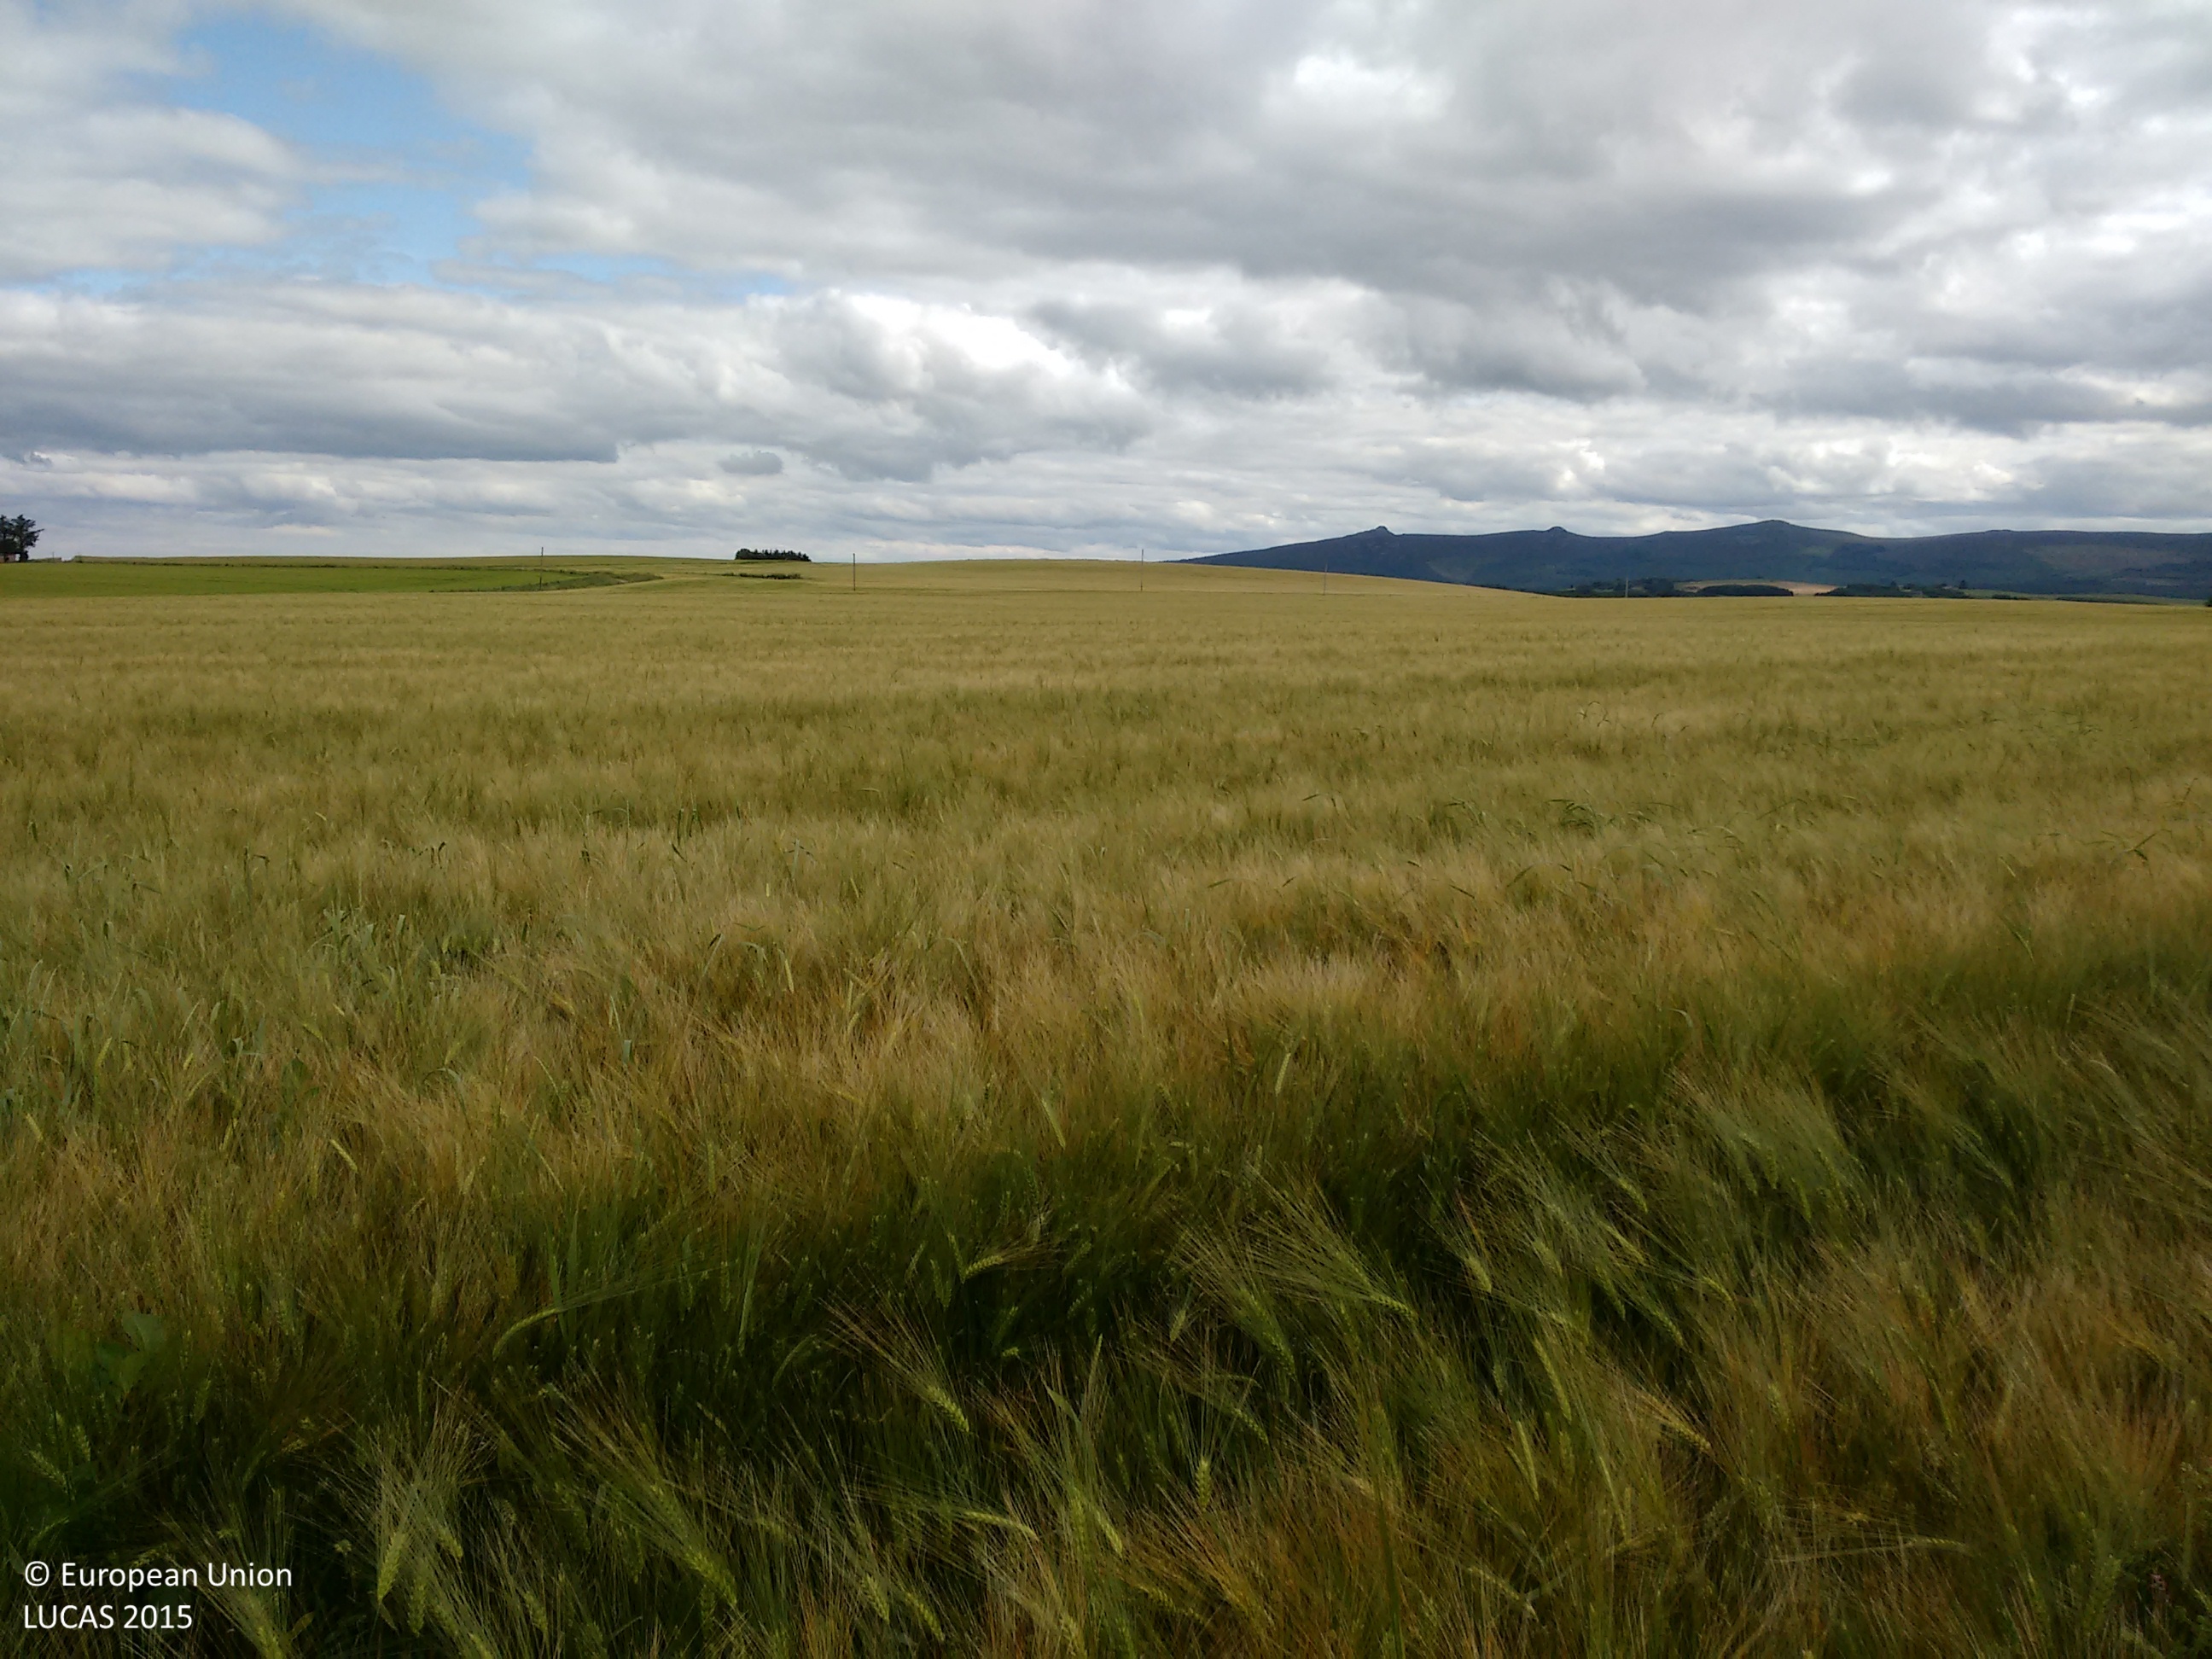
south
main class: Cropland
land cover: Barley
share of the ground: > 75 %
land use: Agriculture (excluding fallow land and kitchen gardens)
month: July
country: GB
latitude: 57.3705
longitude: -2.5758
